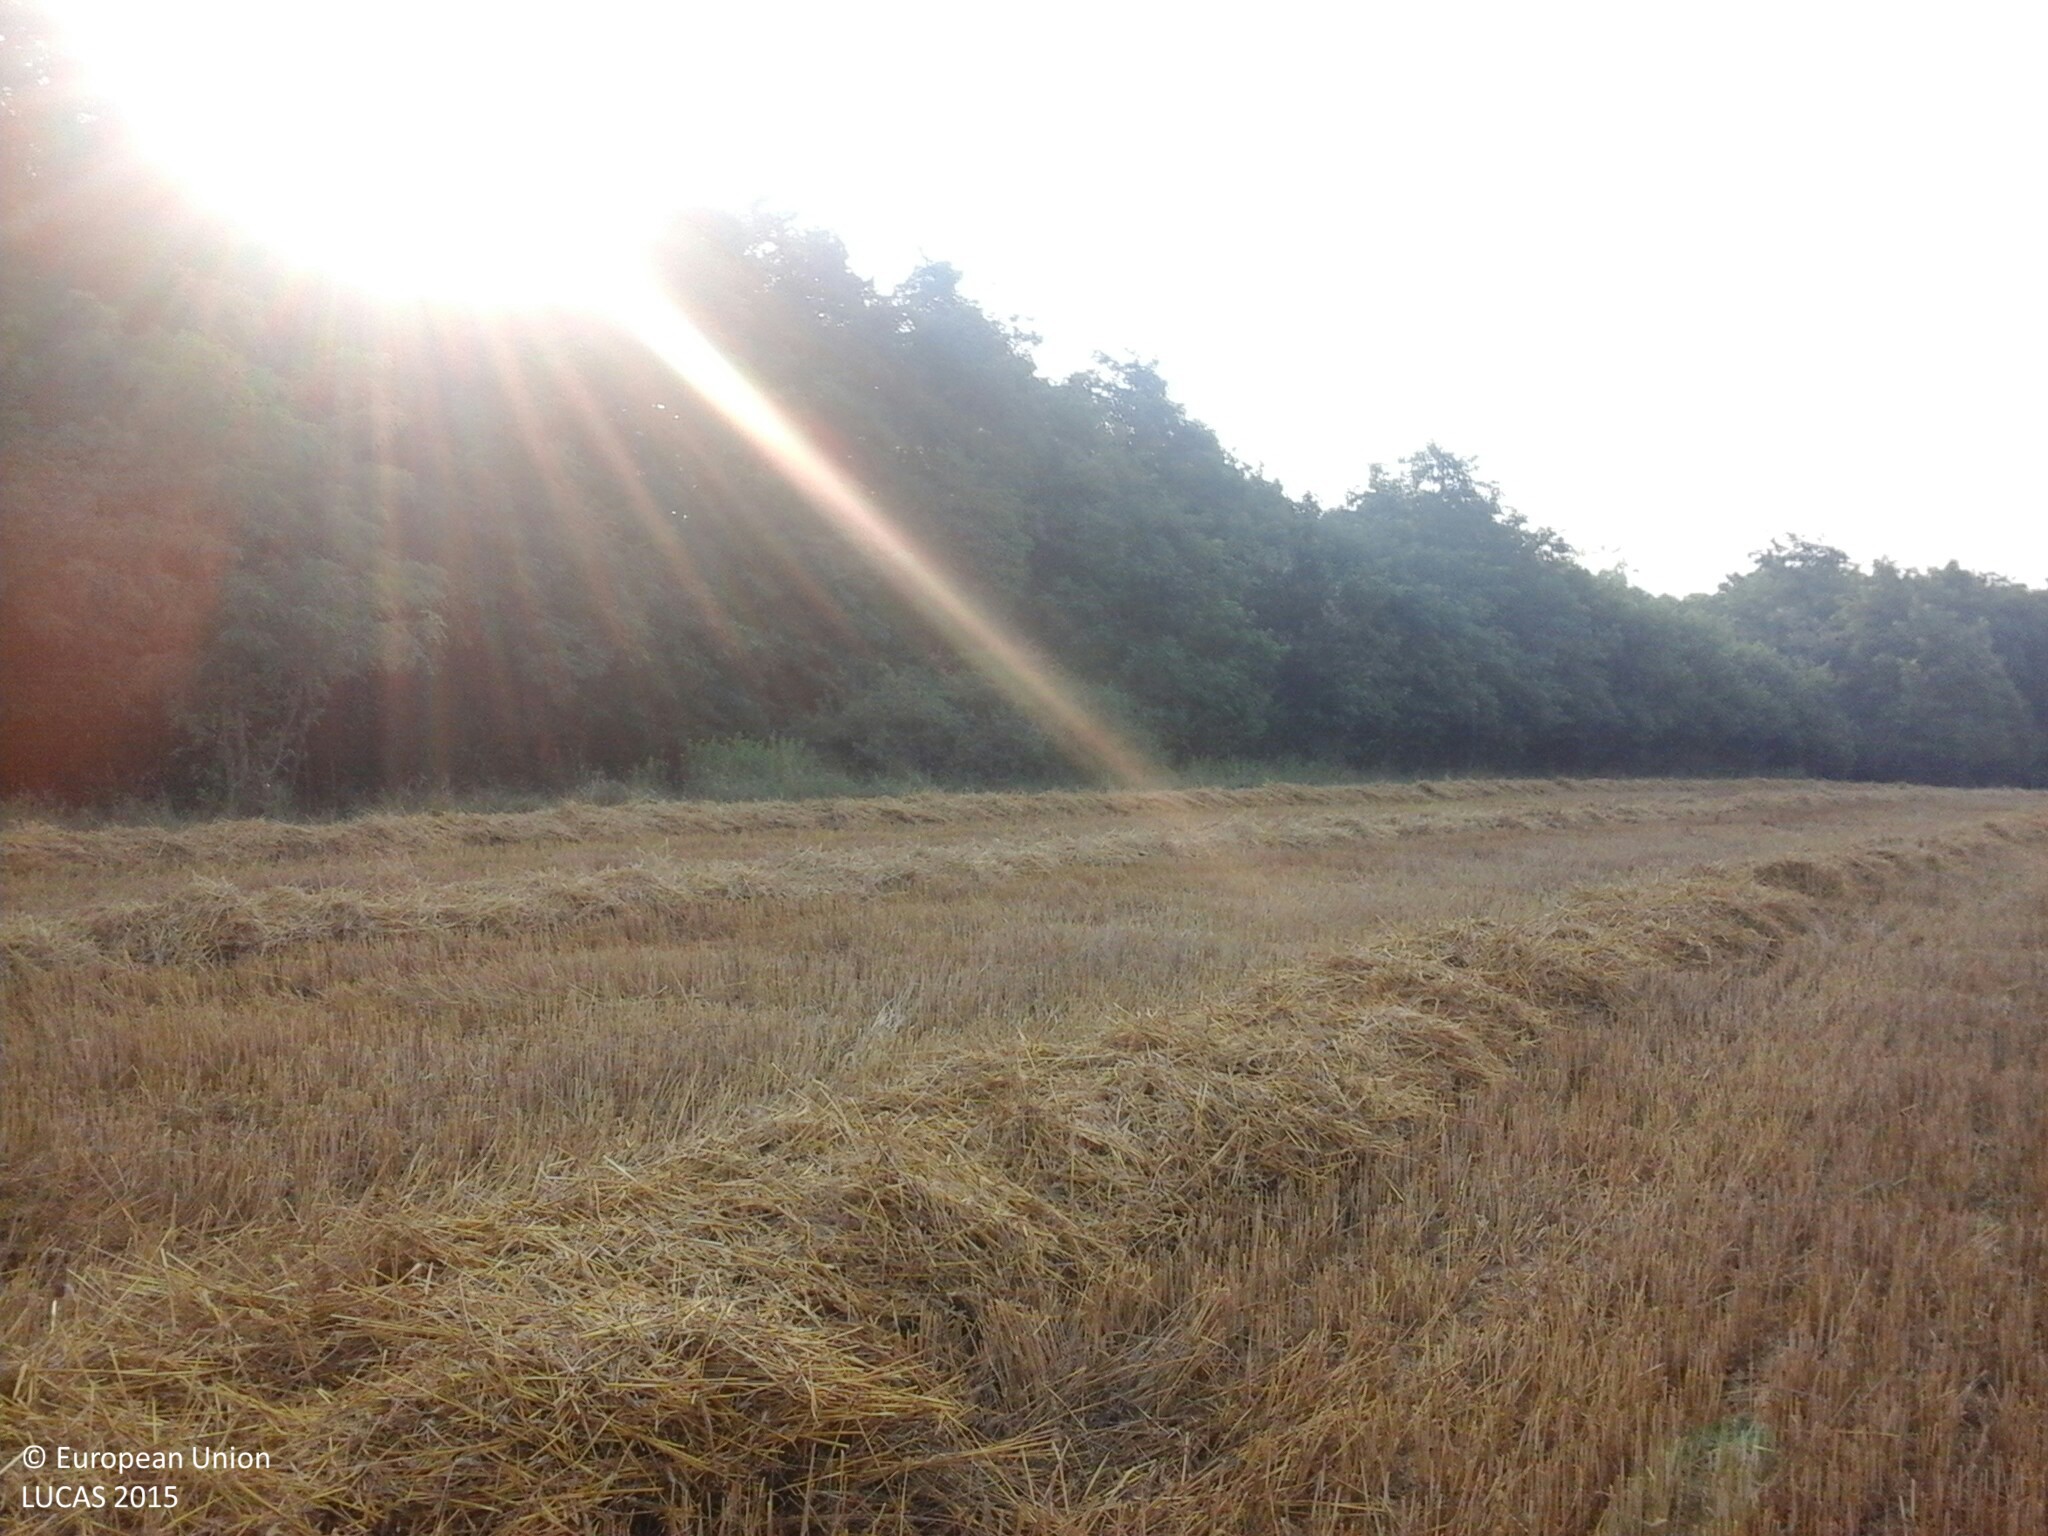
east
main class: Cropland
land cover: Triticale
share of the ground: 50 - 75 %
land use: Agriculture (excluding fallow land and kitchen gardens)
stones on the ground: < 10 %
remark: Harvested field
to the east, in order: Triticale; Grass margins; Tracks; Broadleaved woodland; Rivers and streams; Broadleaved woodland
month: August
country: HU
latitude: 47.4339
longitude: 18.1389
